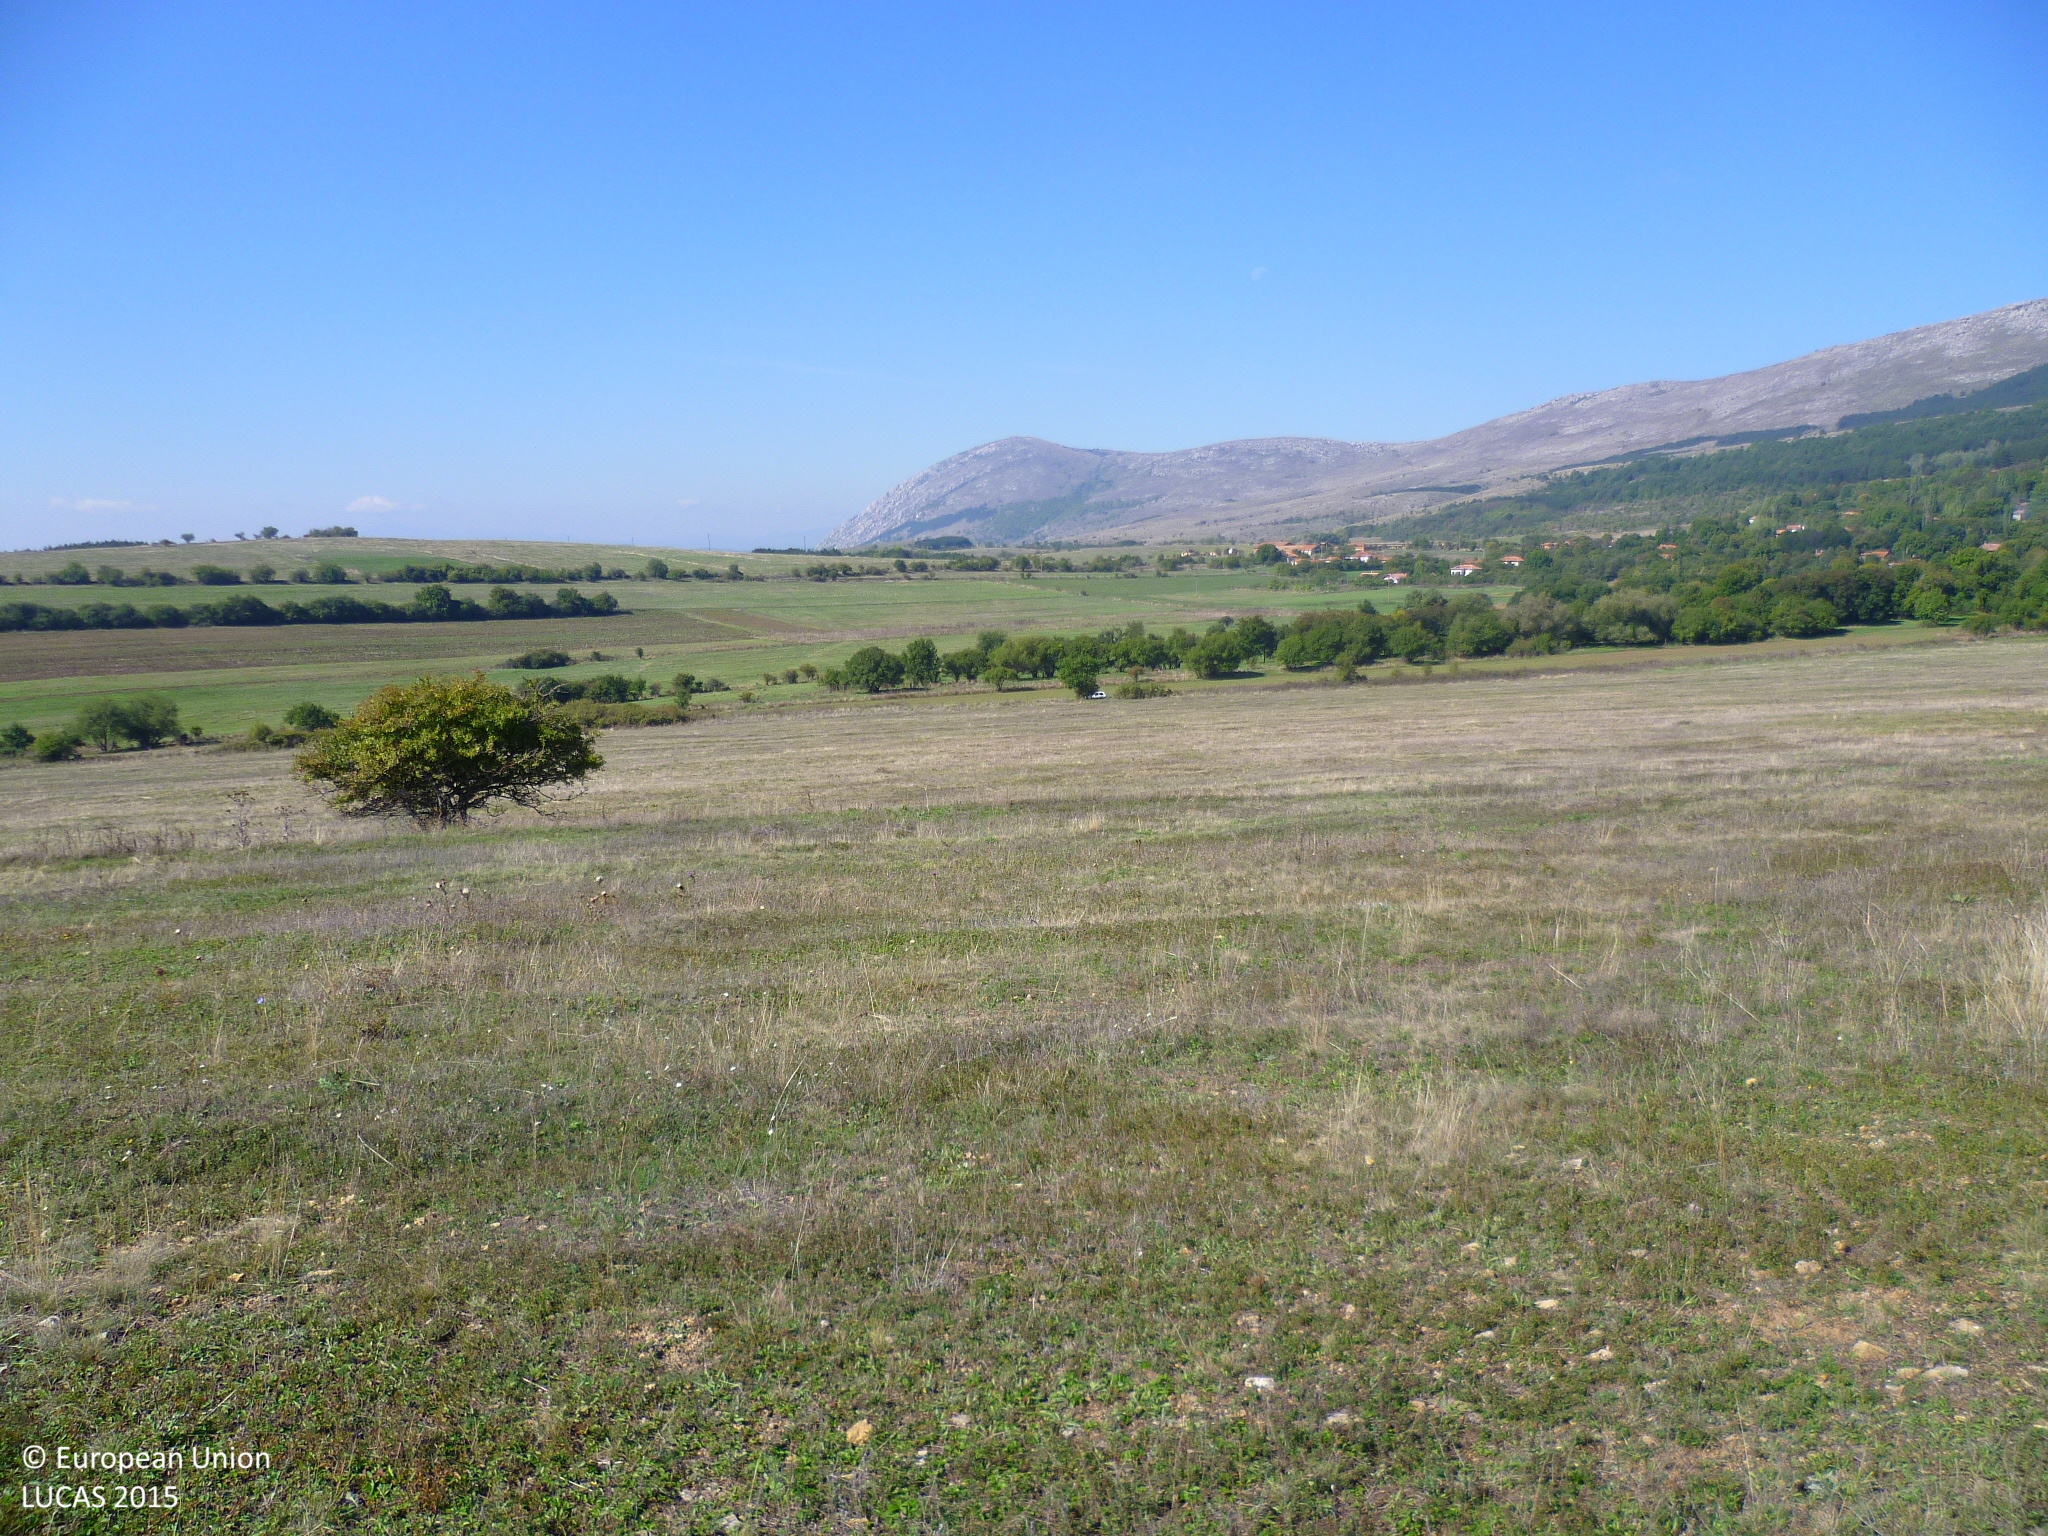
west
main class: Grassland
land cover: Grassland without tree/shrub cover
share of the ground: > 75 %
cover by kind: herbaceous plants 100 %
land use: Agriculture (excluding fallow land and kitchen gardens)
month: October
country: BG
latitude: 42.9402
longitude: 23.0349
